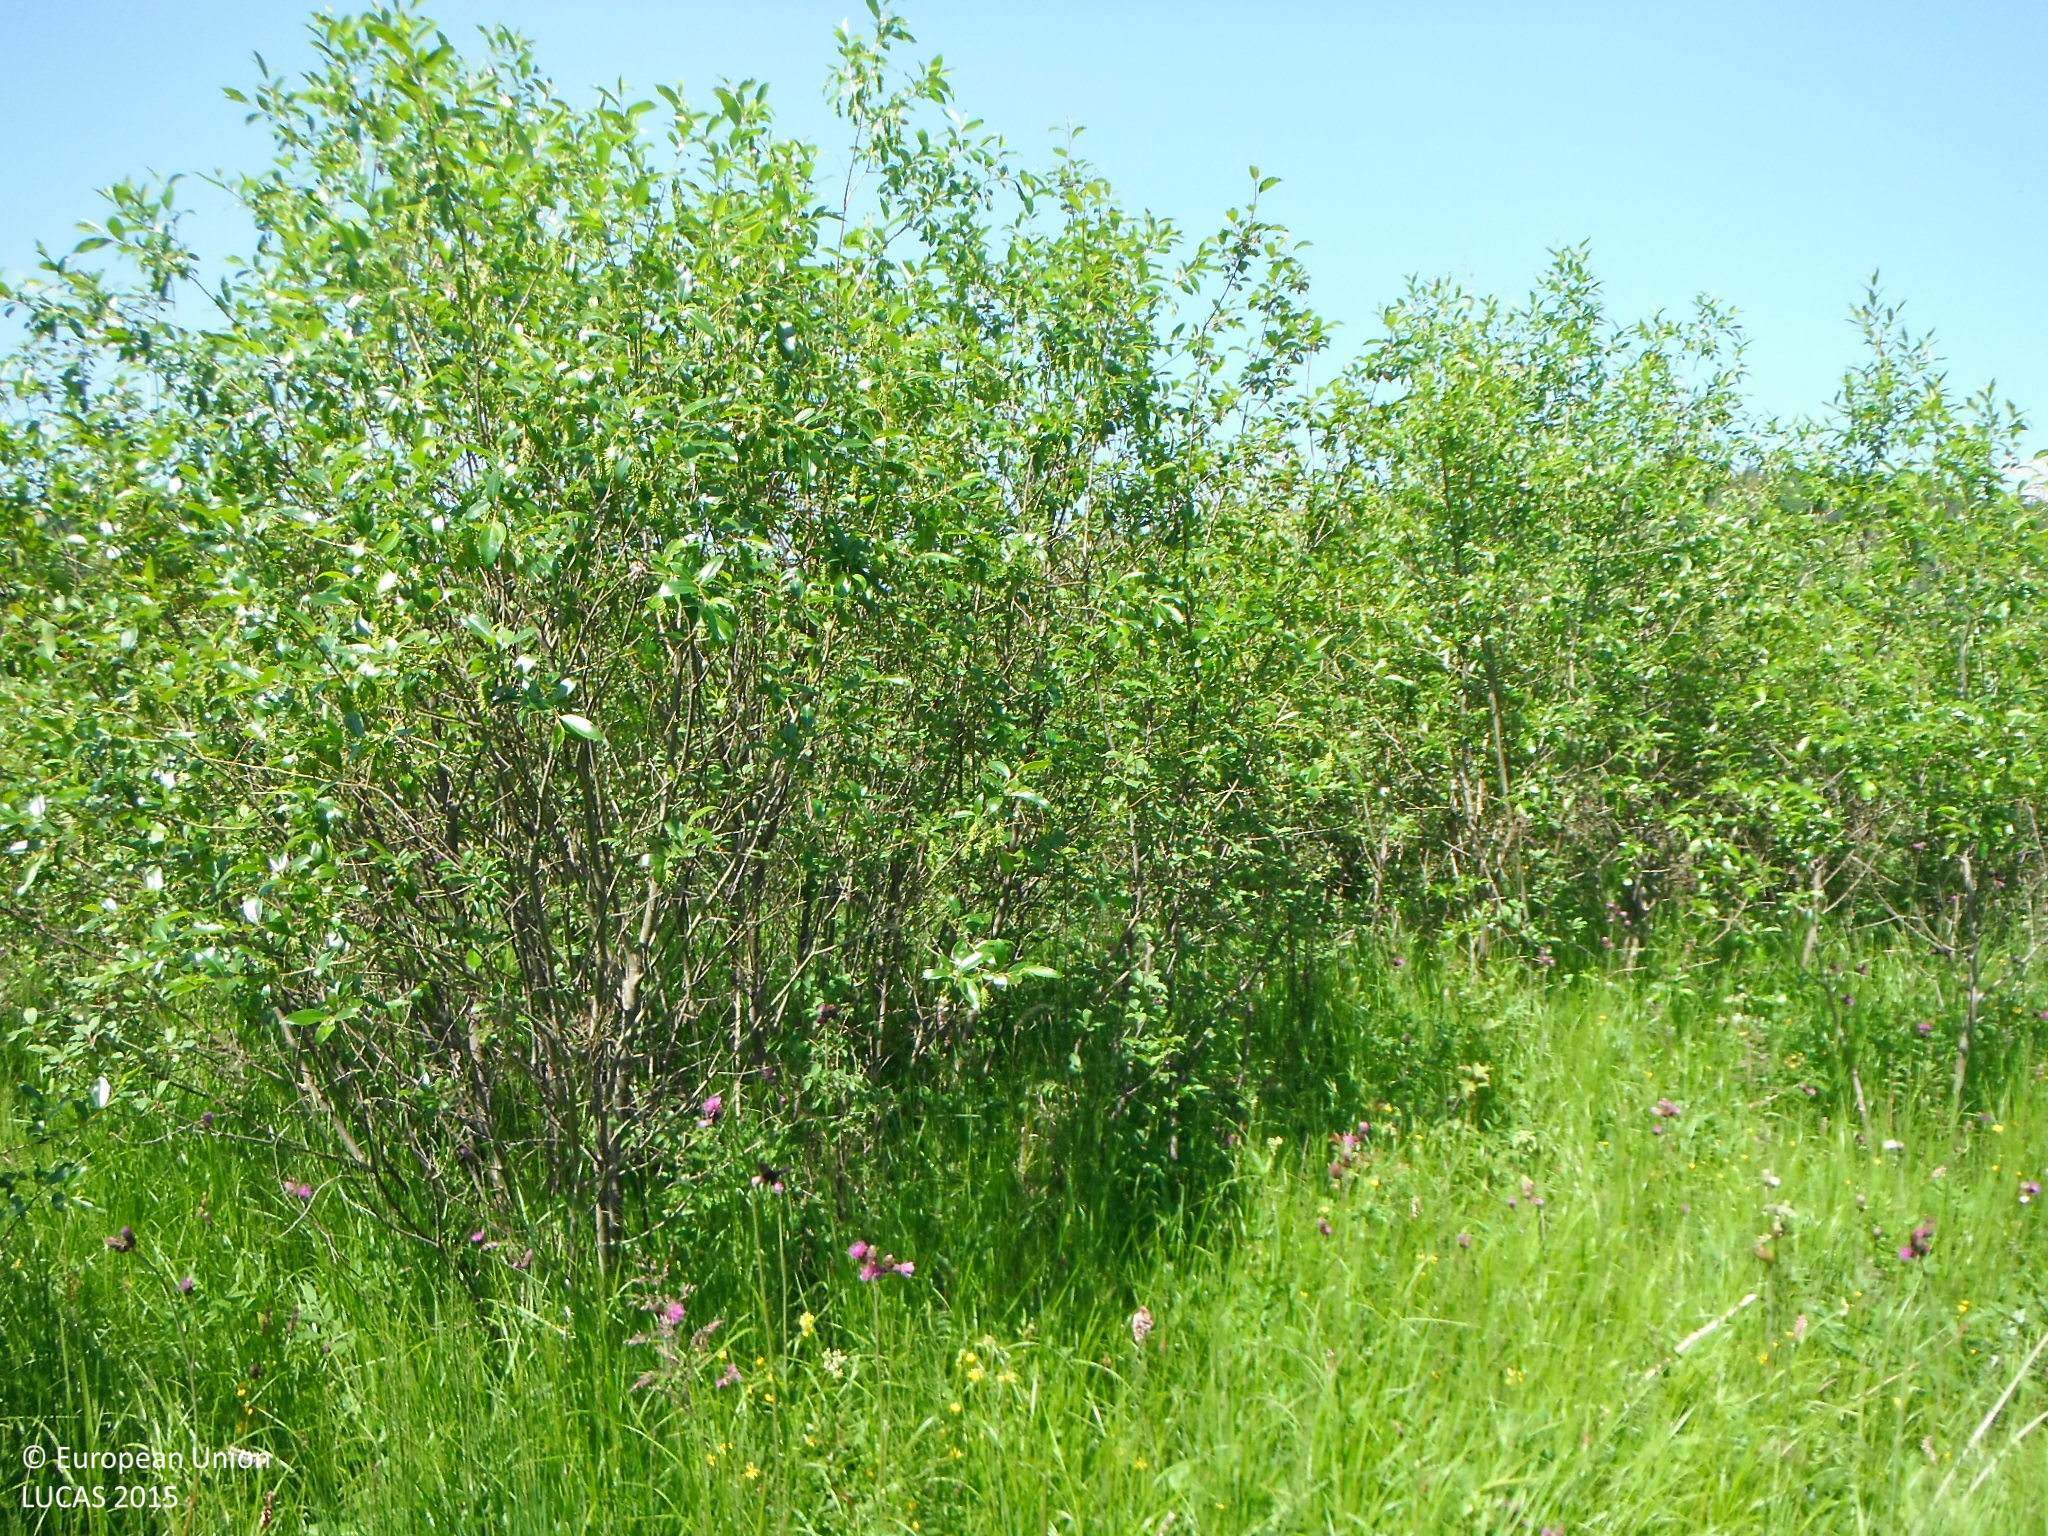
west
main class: Shrubland
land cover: Shrubland without tree cover
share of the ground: > 75 %
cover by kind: shrubs 80 %, herbaceous plants 20 %
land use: Semi-natural and natural areas not in use
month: July
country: SK
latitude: 49.4207
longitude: 19.3303
